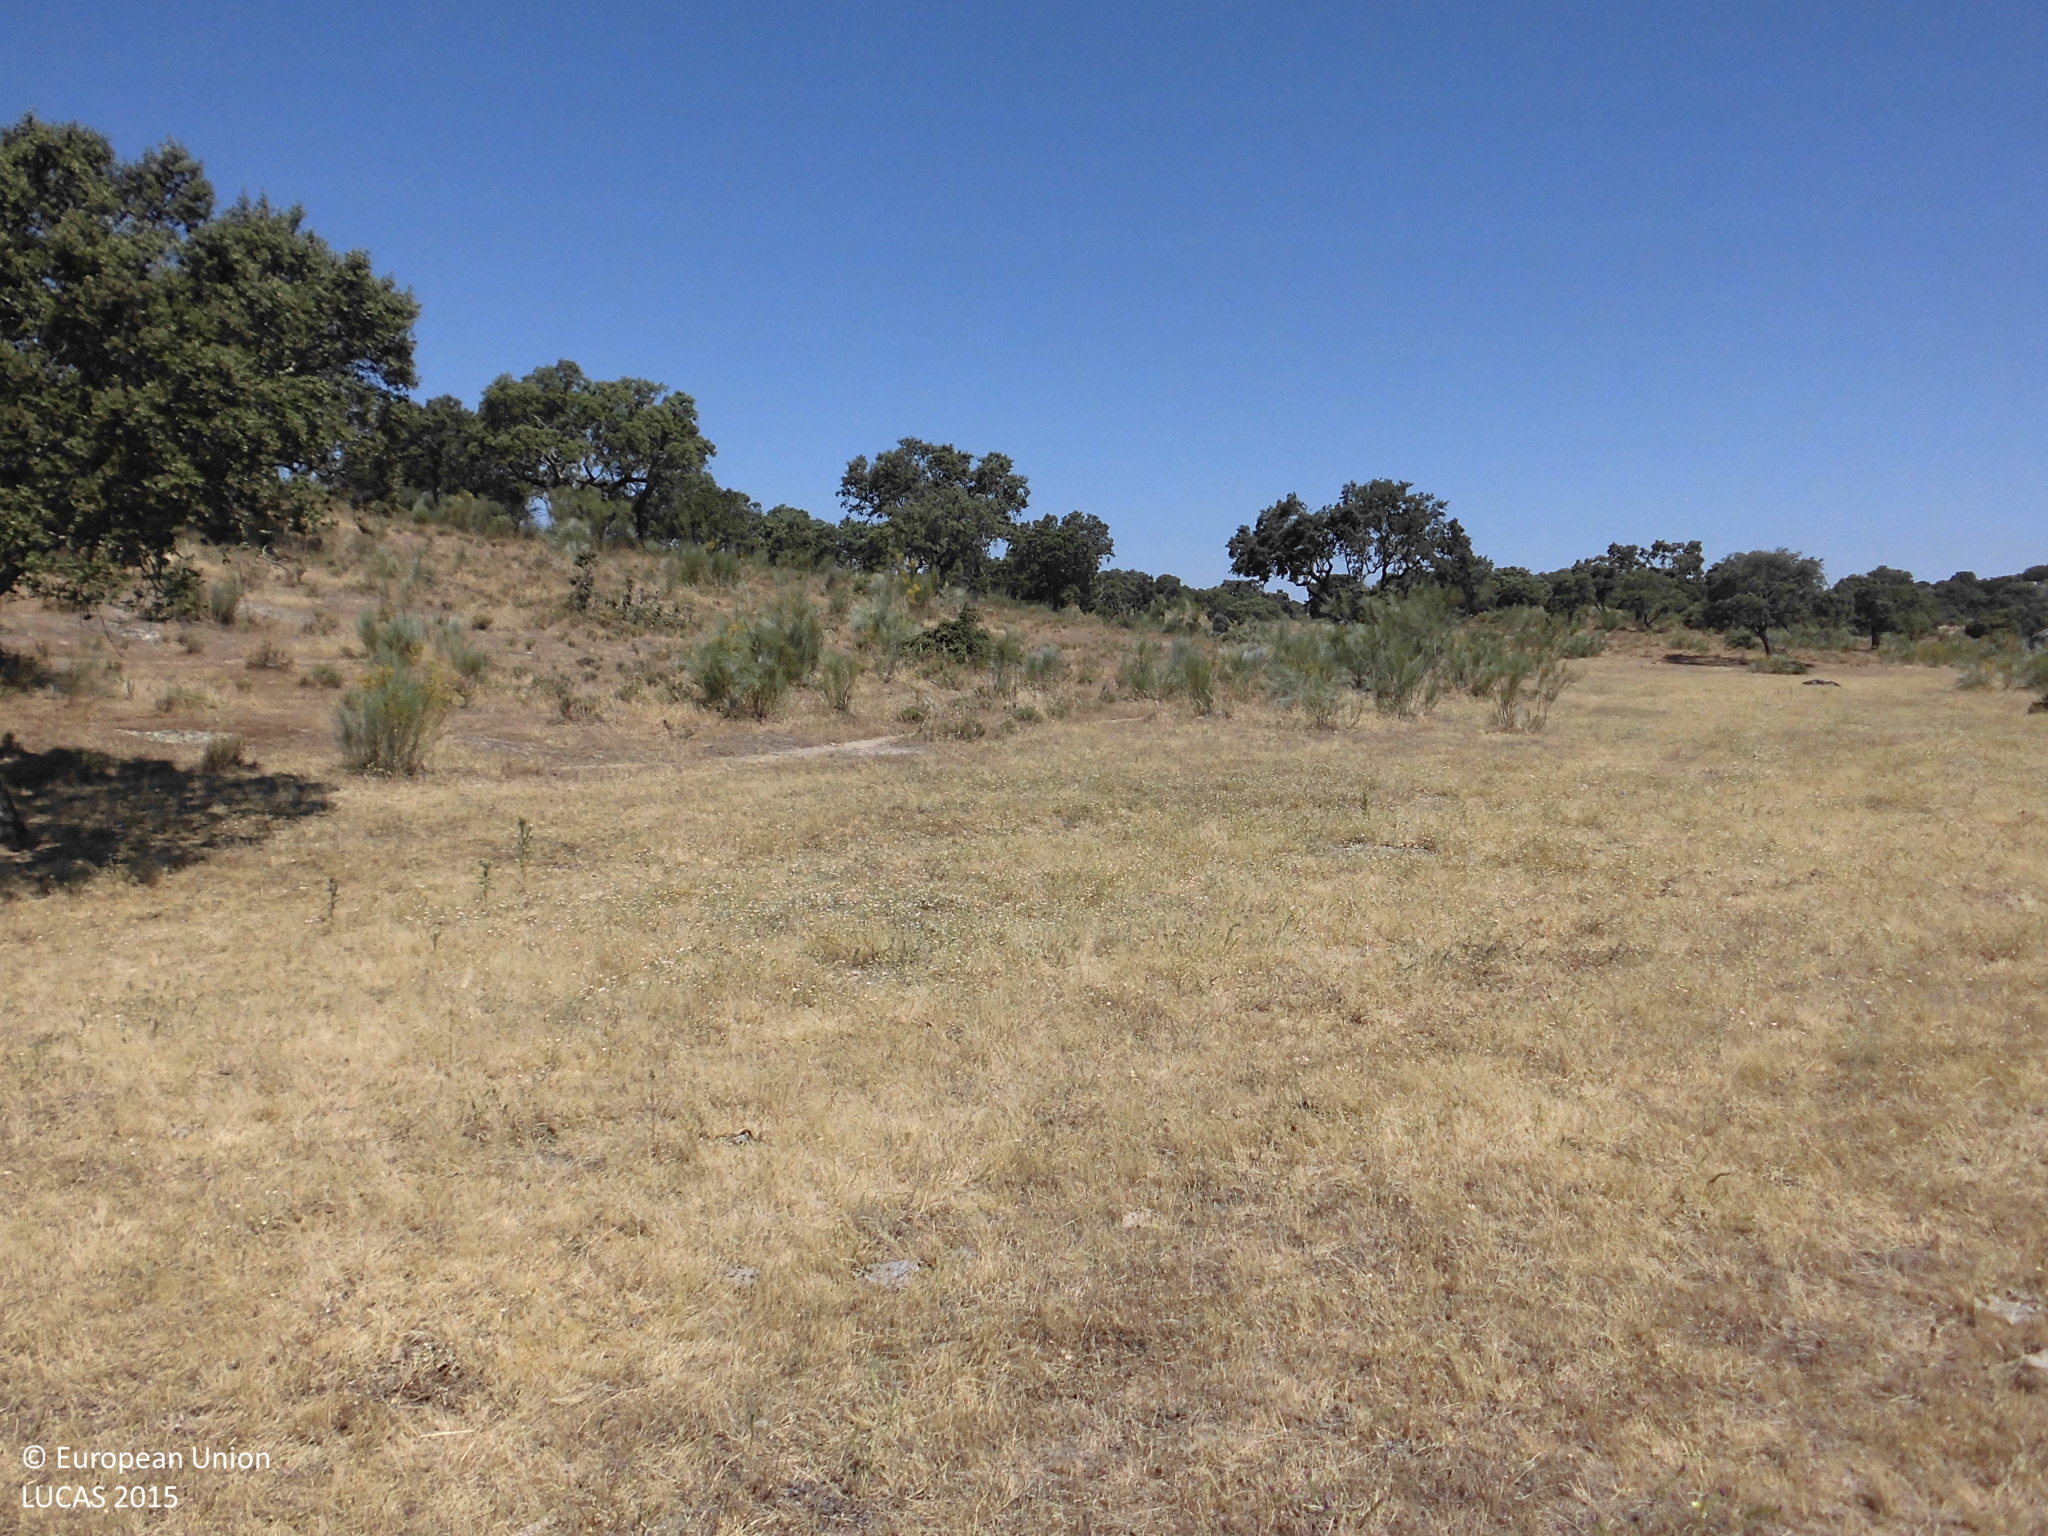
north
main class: Woodland
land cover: Broadleaved woodland
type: broadleaved evergreen forest
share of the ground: 10 - 25 %
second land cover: Grassland without tree/shrub cover
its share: > 75 %
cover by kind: herbaceous plants 85 %, broadleaved forest trees 15 %
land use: Forestry
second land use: Agriculture (excluding fallow land and kitchen gardens)
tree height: > 5 m
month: May
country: ES
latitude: 39.6876
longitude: -6.7181
